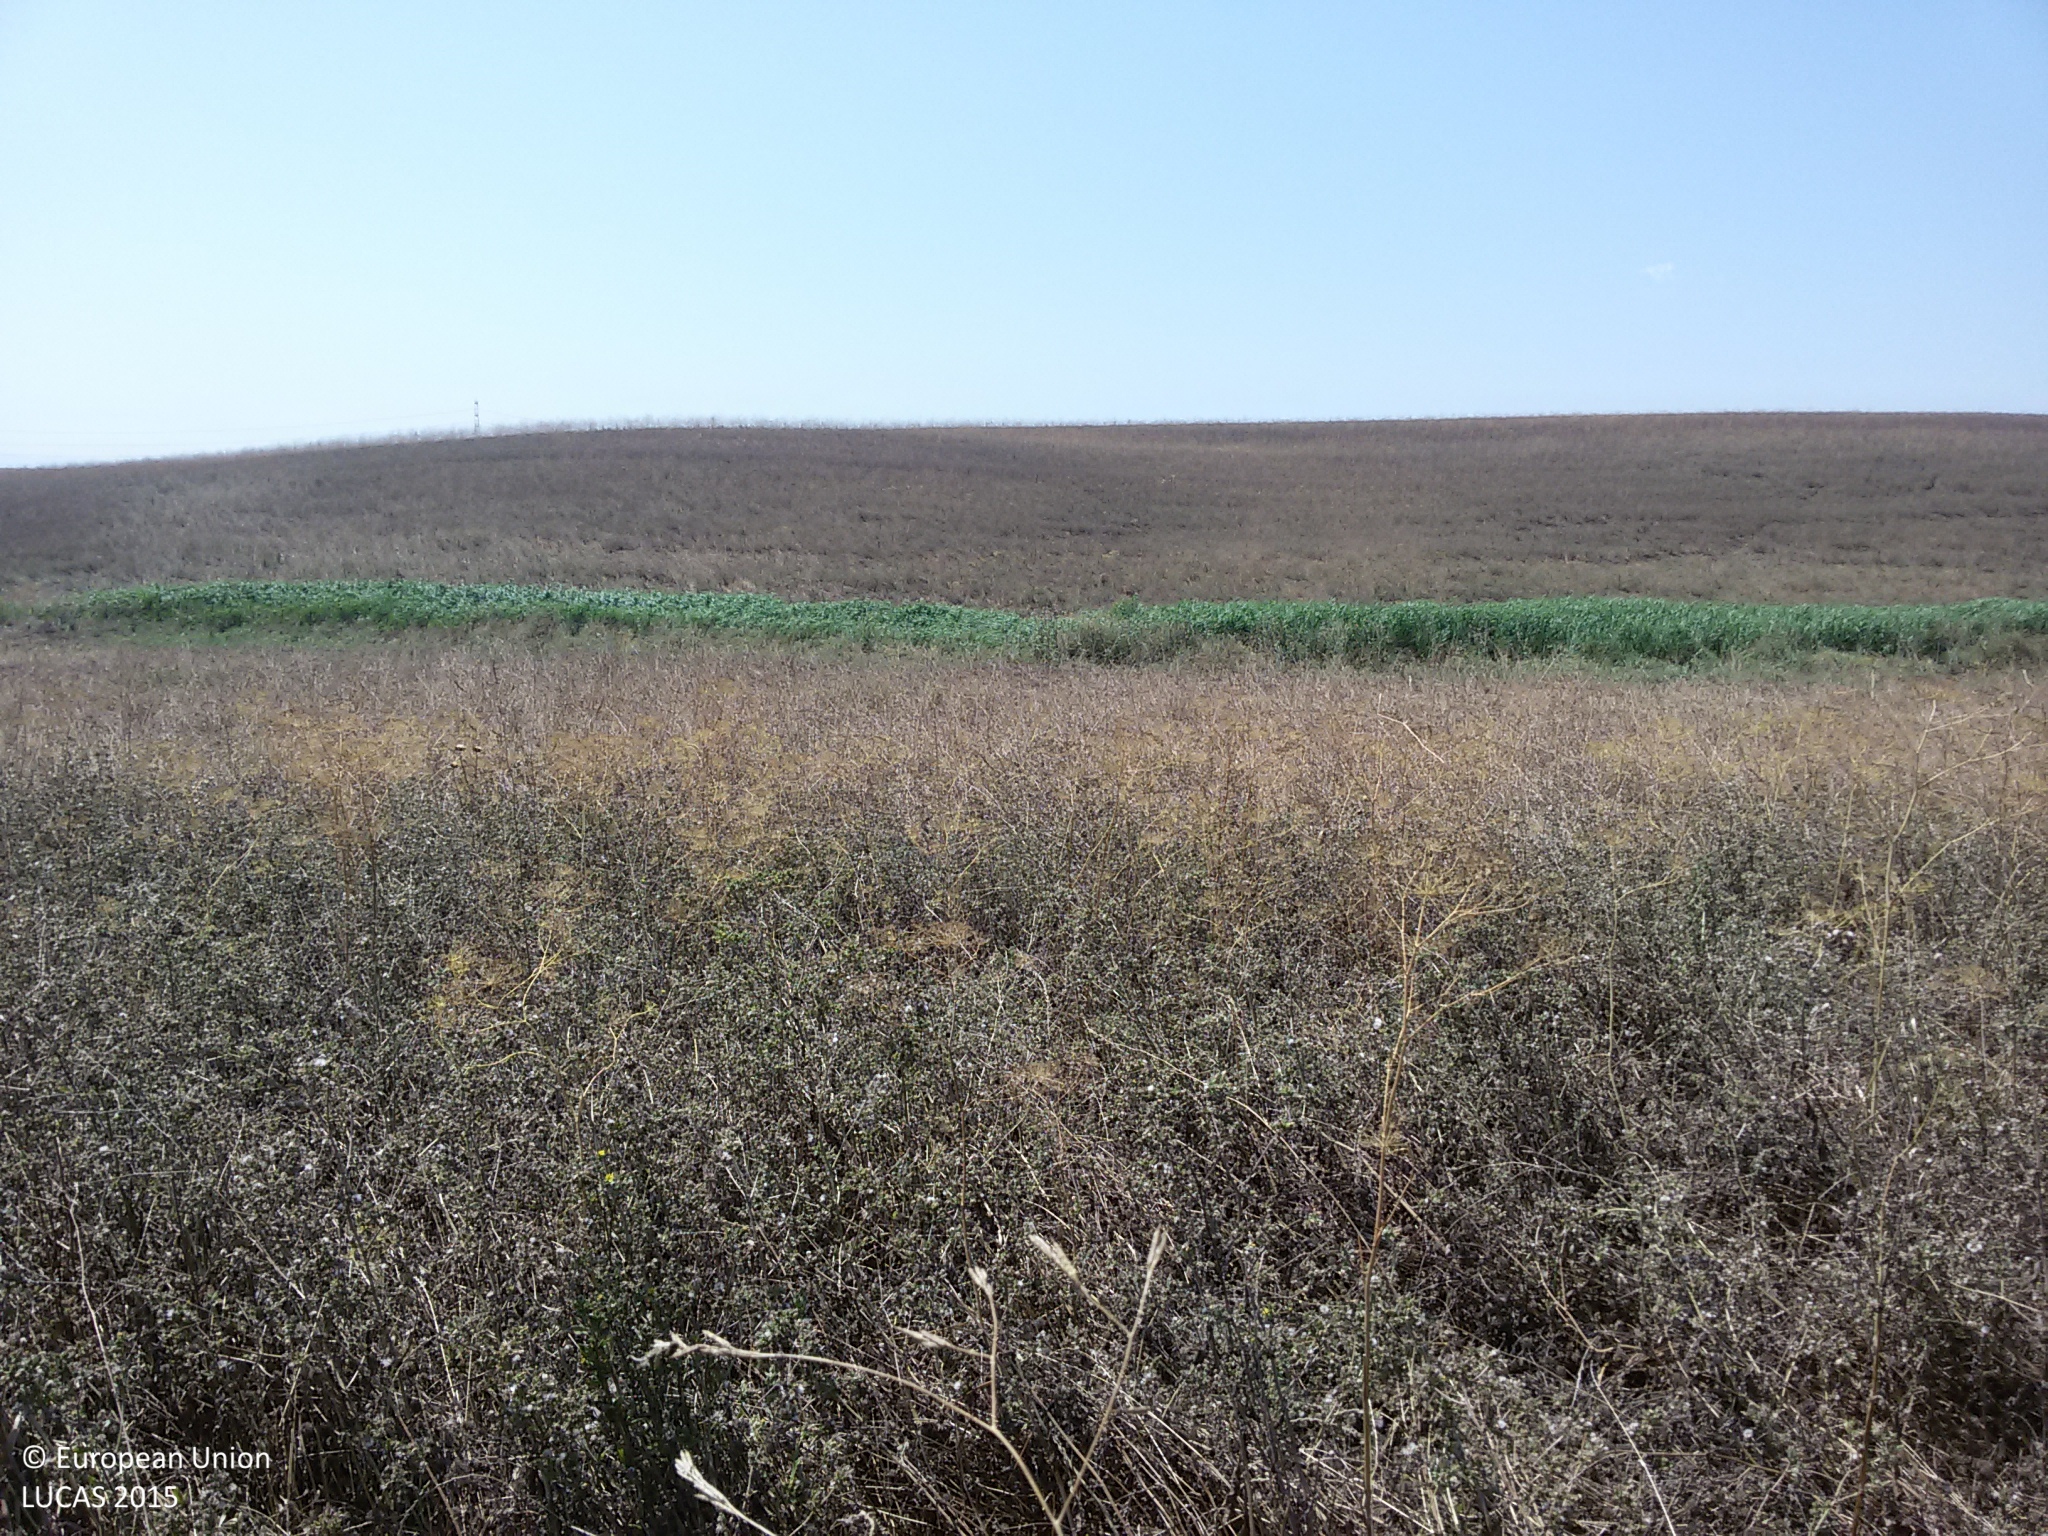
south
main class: Grassland
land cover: Grassland without tree/shrub cover
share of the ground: > 75 %
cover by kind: herbaceous plants 95 %, unconsolidated bare surface 5 %
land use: Agriculture (excluding fallow land and kitchen gardens)
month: July
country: IT
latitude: 42.4429
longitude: 11.5871
